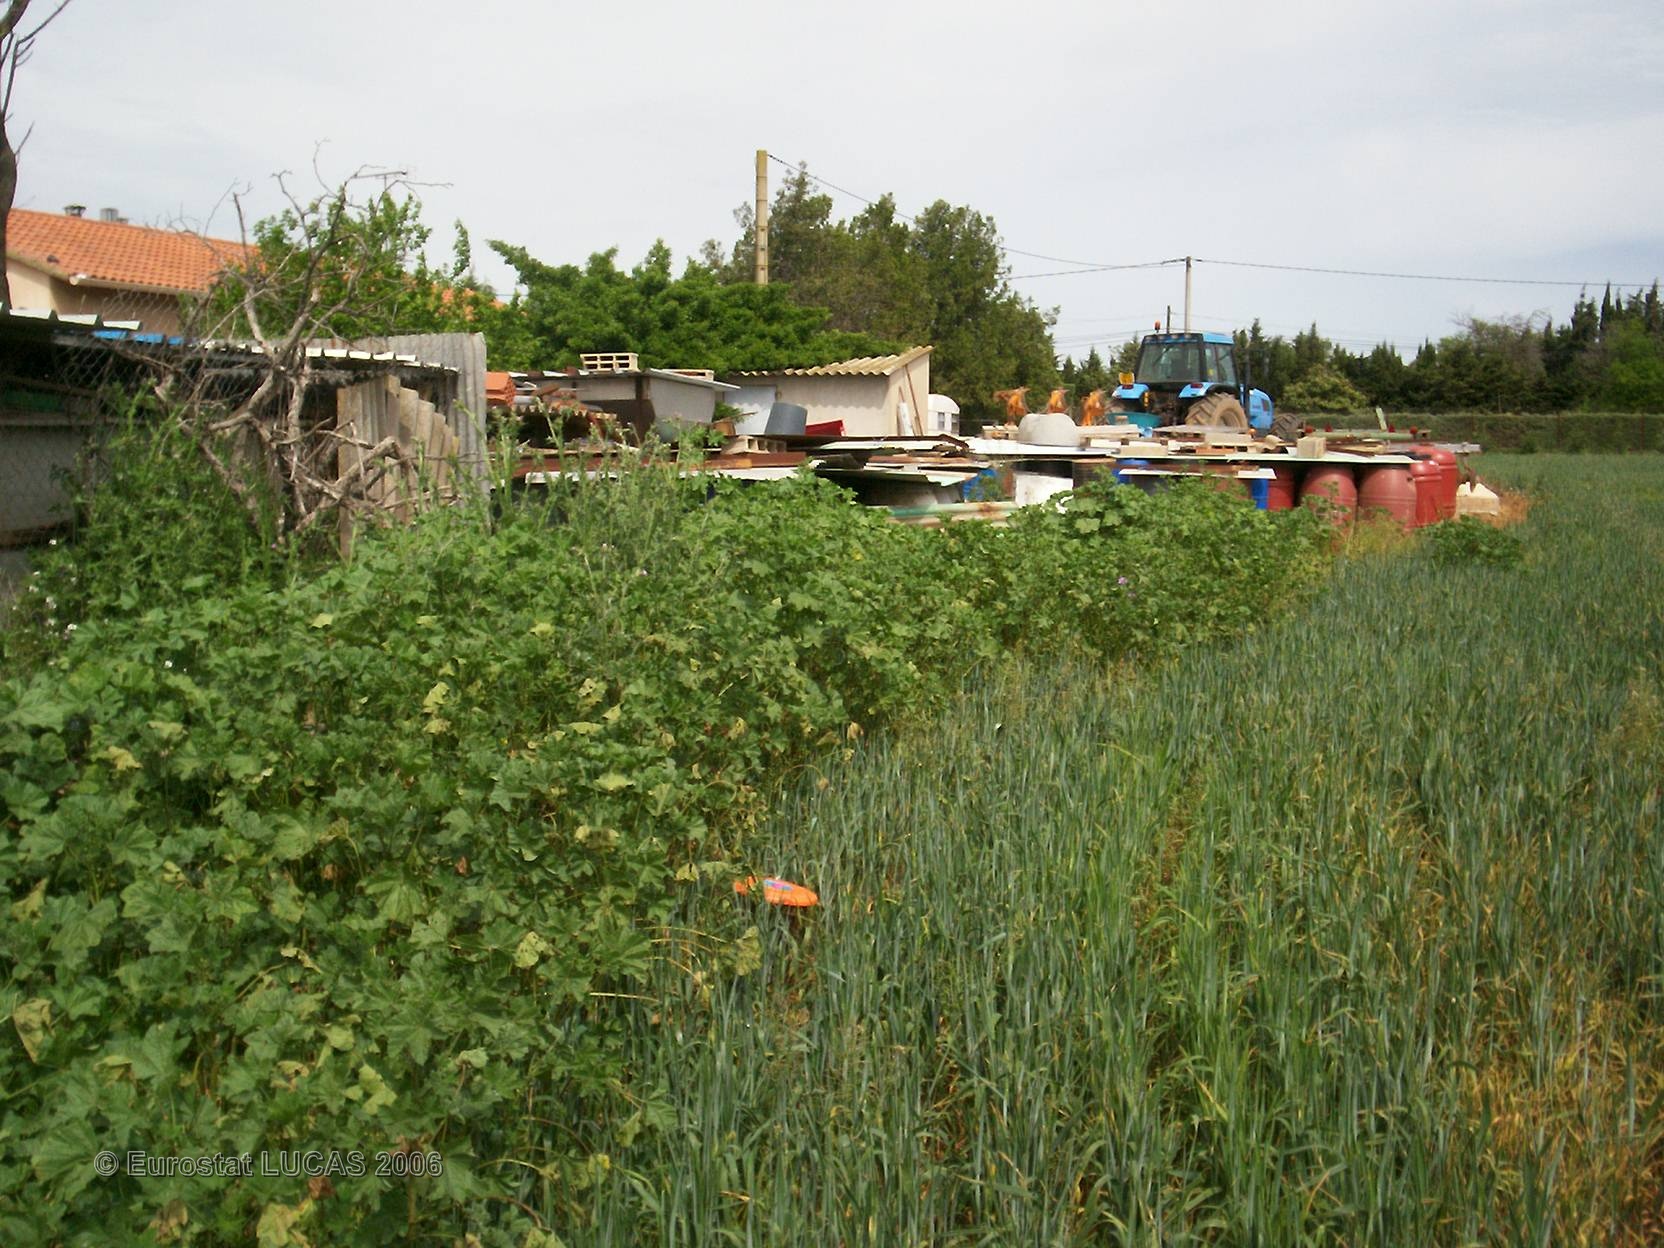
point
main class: Cropland
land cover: Common wheat
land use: Agriculture (excluding fallow land and kitchen gardens)
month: April
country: FR
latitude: 43.4018
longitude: 3.4530
